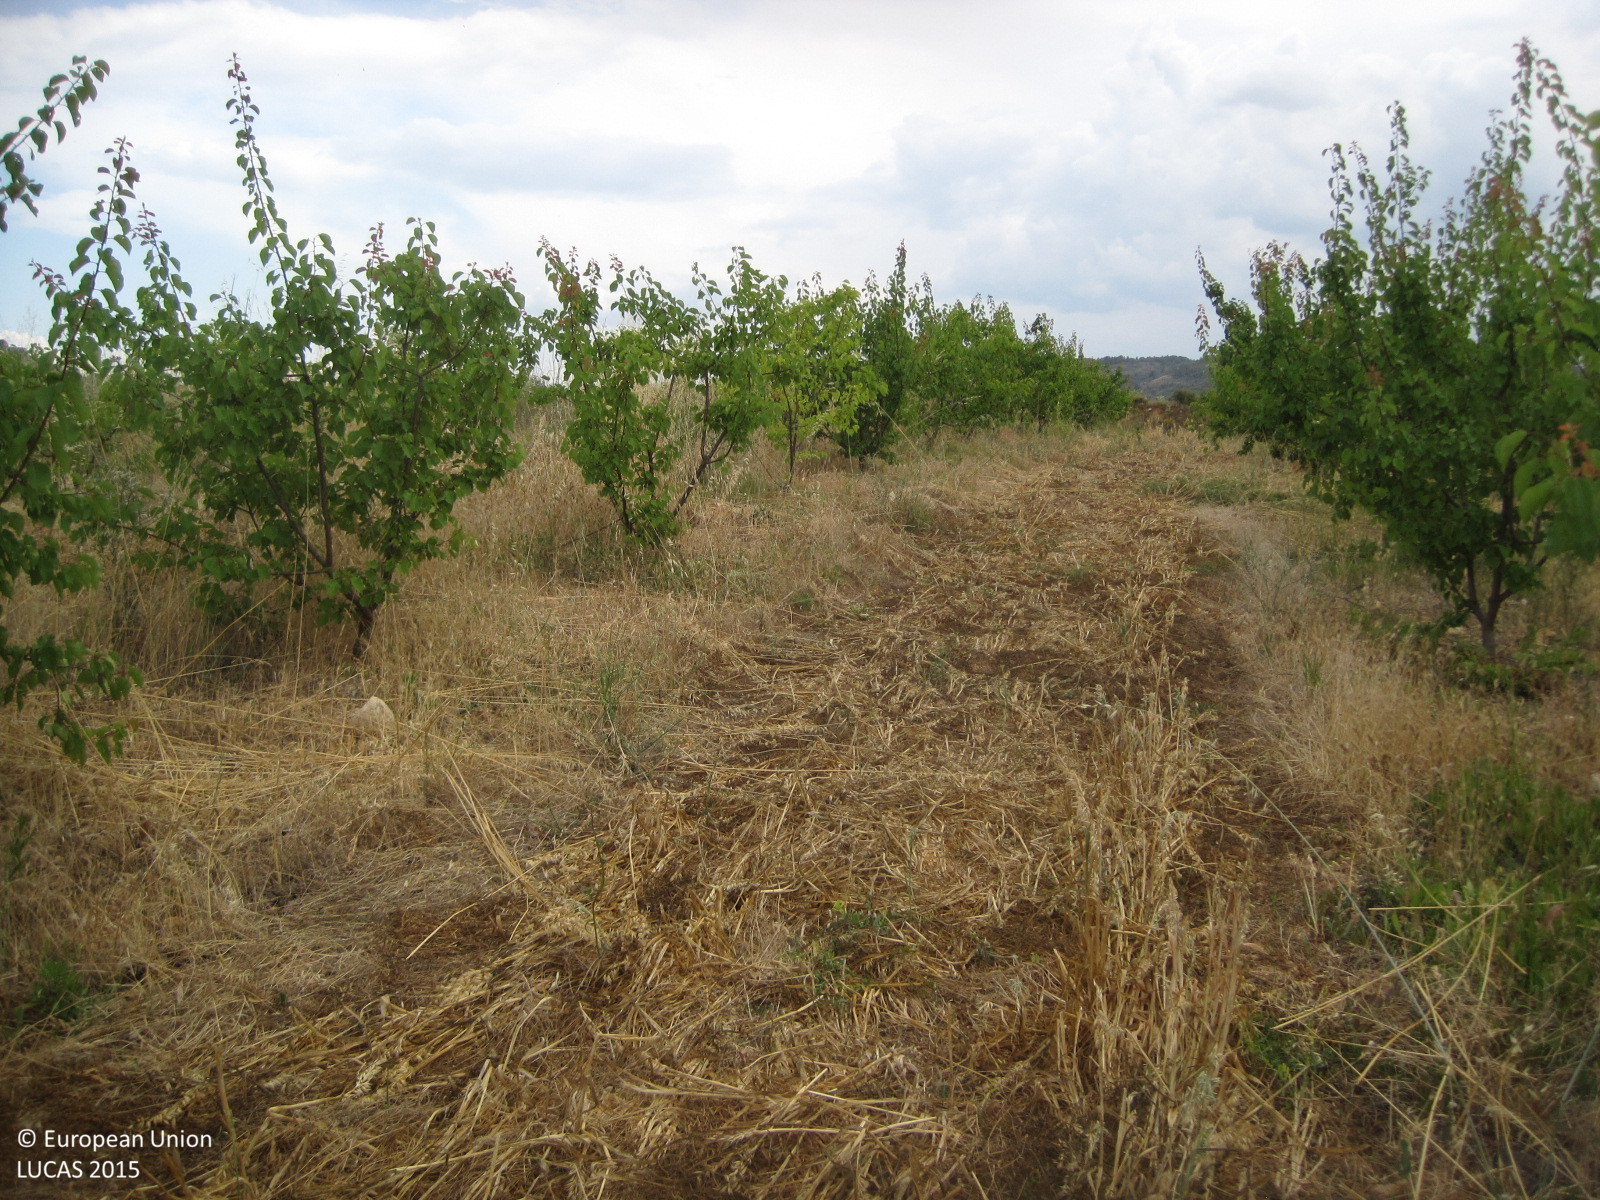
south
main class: Cropland
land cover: Other fruit trees and berries
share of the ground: 10 - 25 %
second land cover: Spontaneously vegetated surfaces
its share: > 75 %
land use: Agriculture (excluding fallow land and kitchen gardens)
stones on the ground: 10 - 25 %
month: June
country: ES
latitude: 39.3075
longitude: -0.6079
